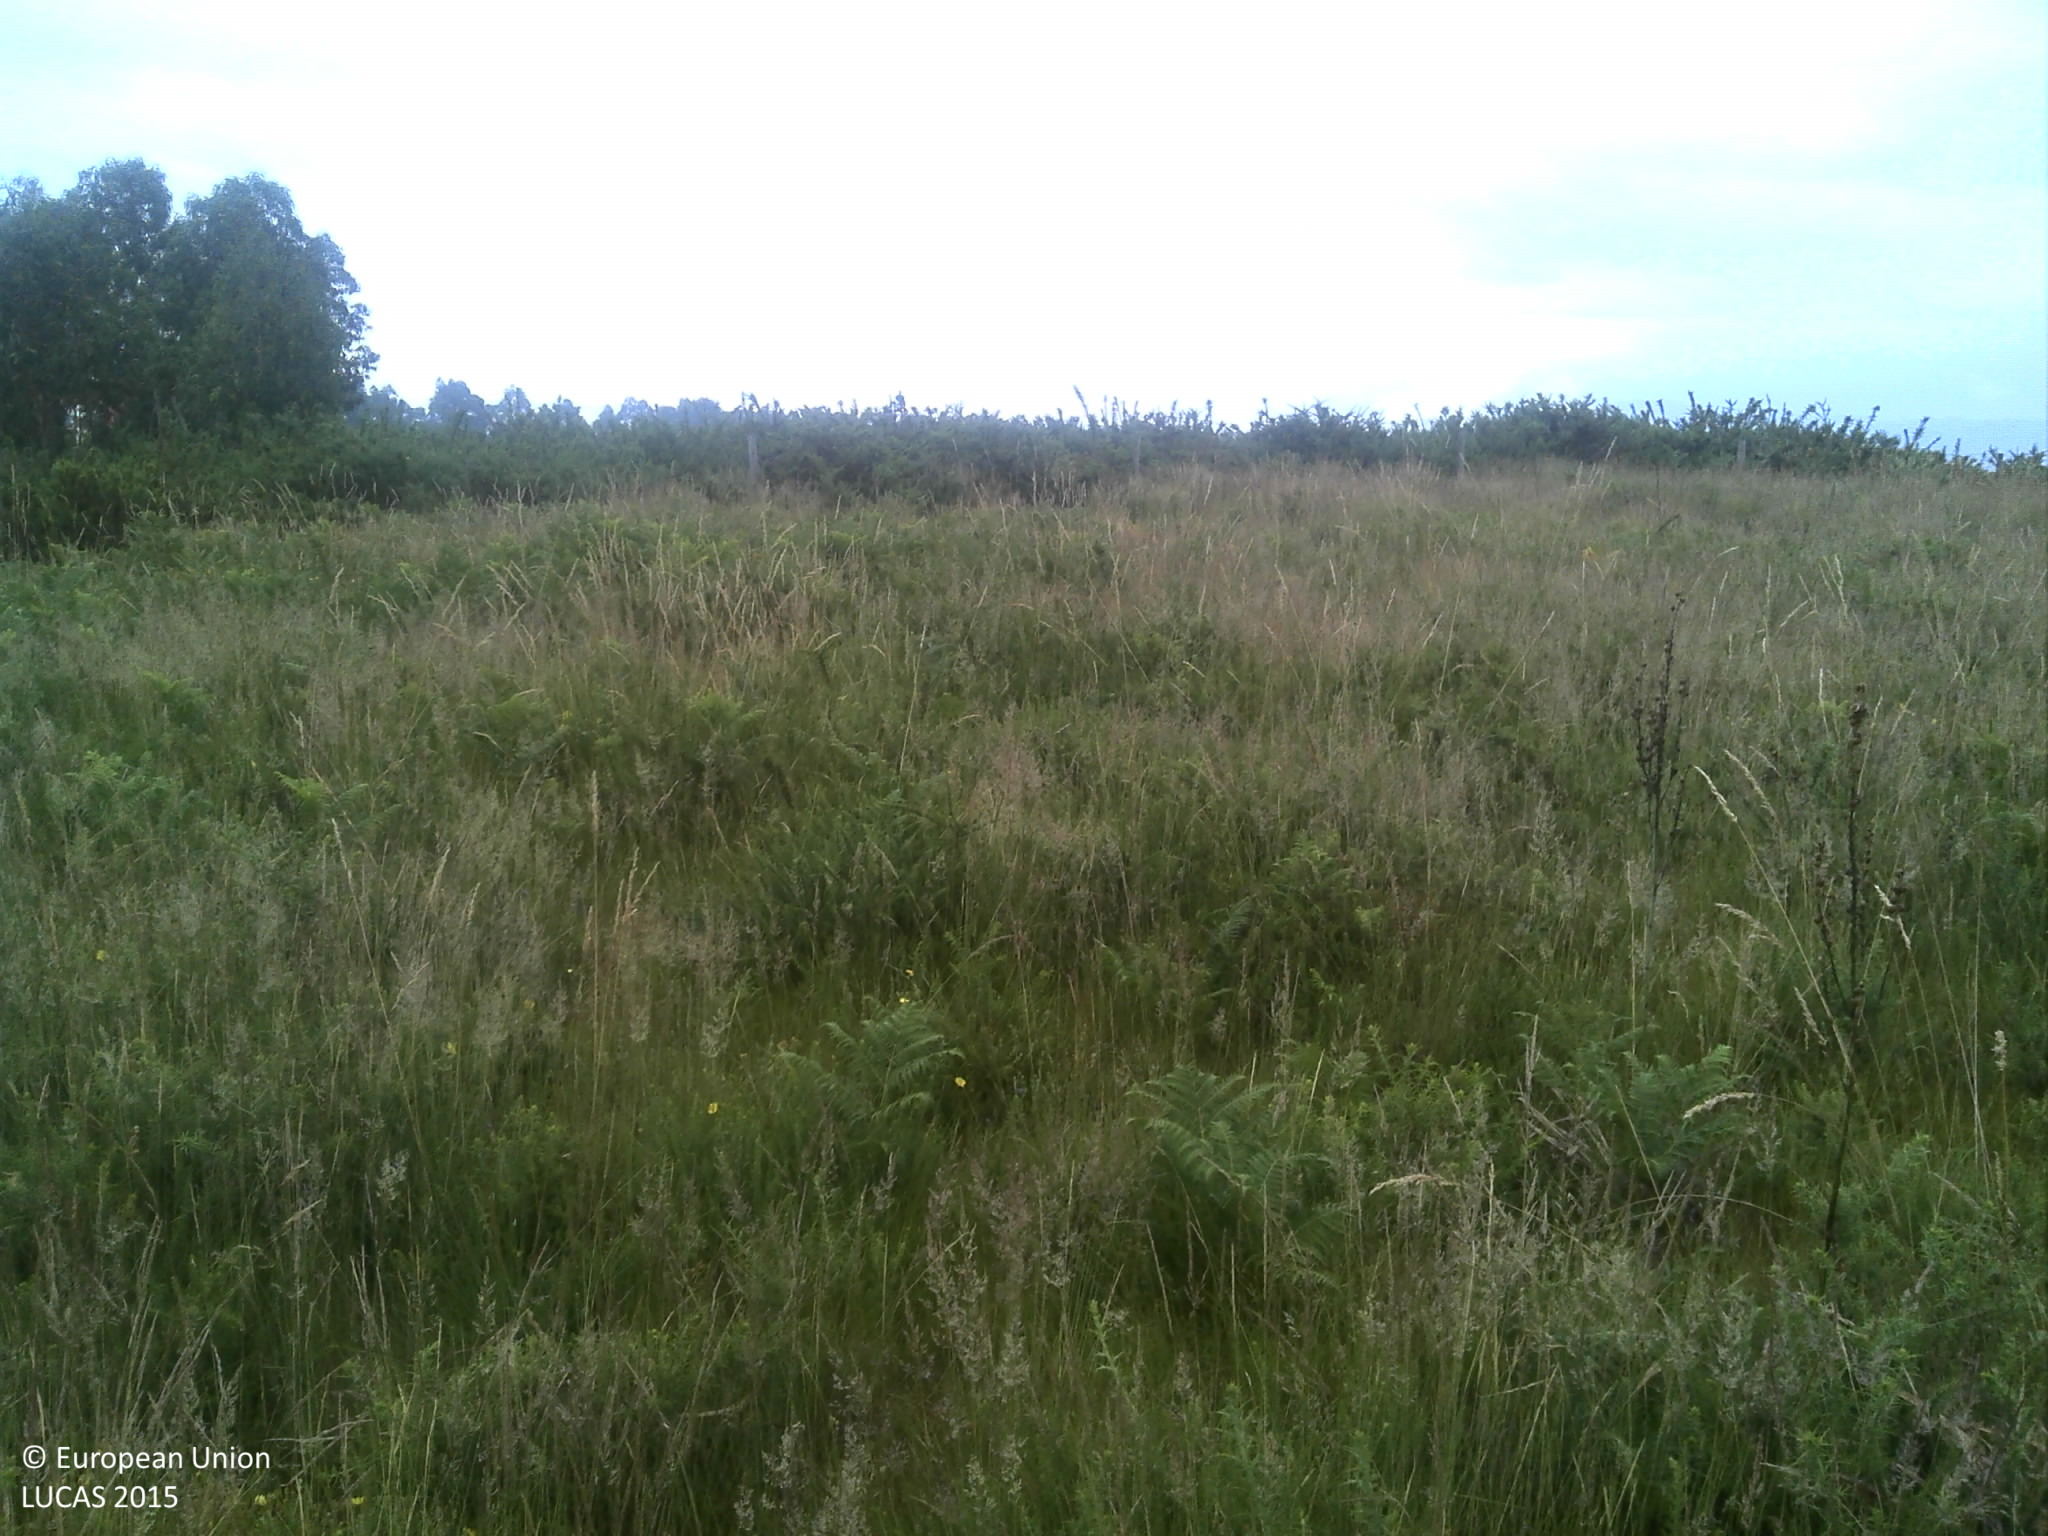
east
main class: Shrubland
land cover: Shrubland without tree cover
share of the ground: > 75 %
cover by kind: shrubs 55 %, herbaceous plants 40 %, unconsolidated bare surface 5 %
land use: Agriculture (excluding fallow land and kitchen gardens)
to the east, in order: Shrubland without tree cover; Electric lines; Fences; Shrubland without tree cover; Broadleaved woodland; Shrubland without tree cover
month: June
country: PT
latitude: 41.5755
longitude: -8.3212
